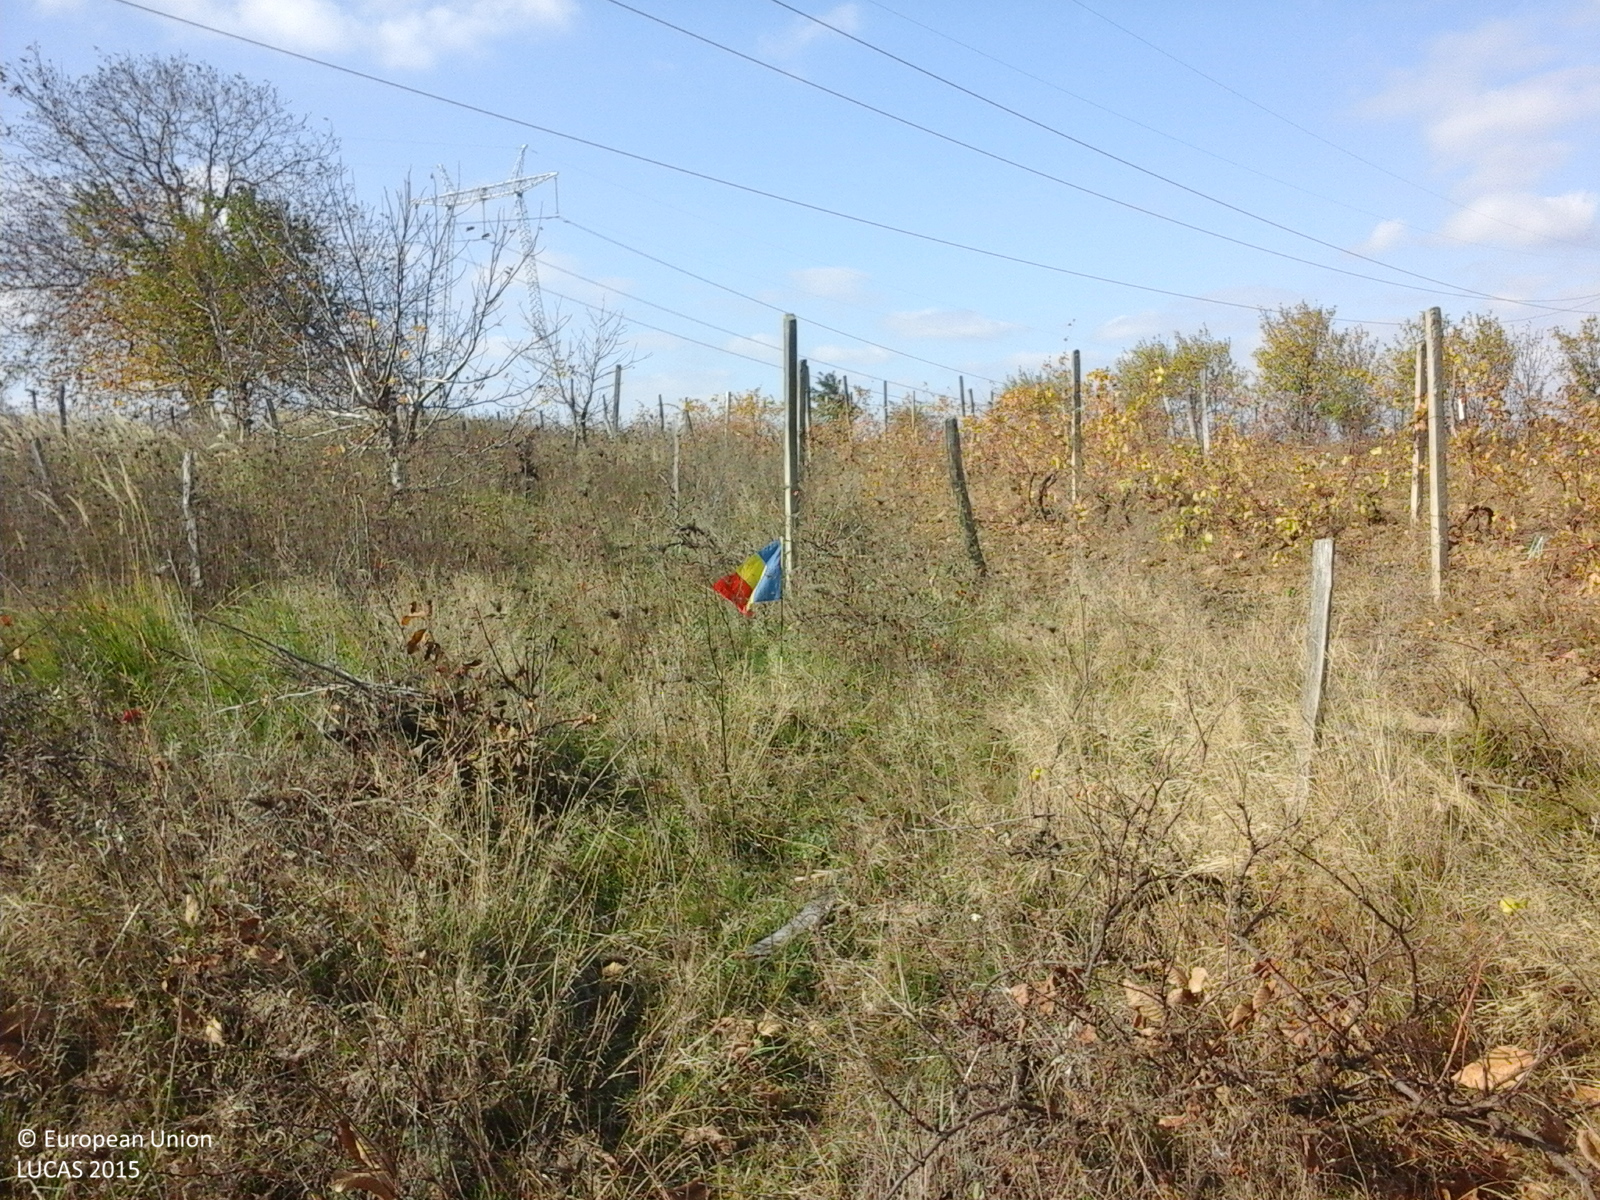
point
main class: Cropland
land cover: Vineyards
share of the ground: > 75 %
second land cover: Spontaneously vegetated surfaces
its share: > 75 %
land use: Agriculture (excluding fallow land and kitchen gardens)
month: October
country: RO
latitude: 45.9874
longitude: 27.1231
